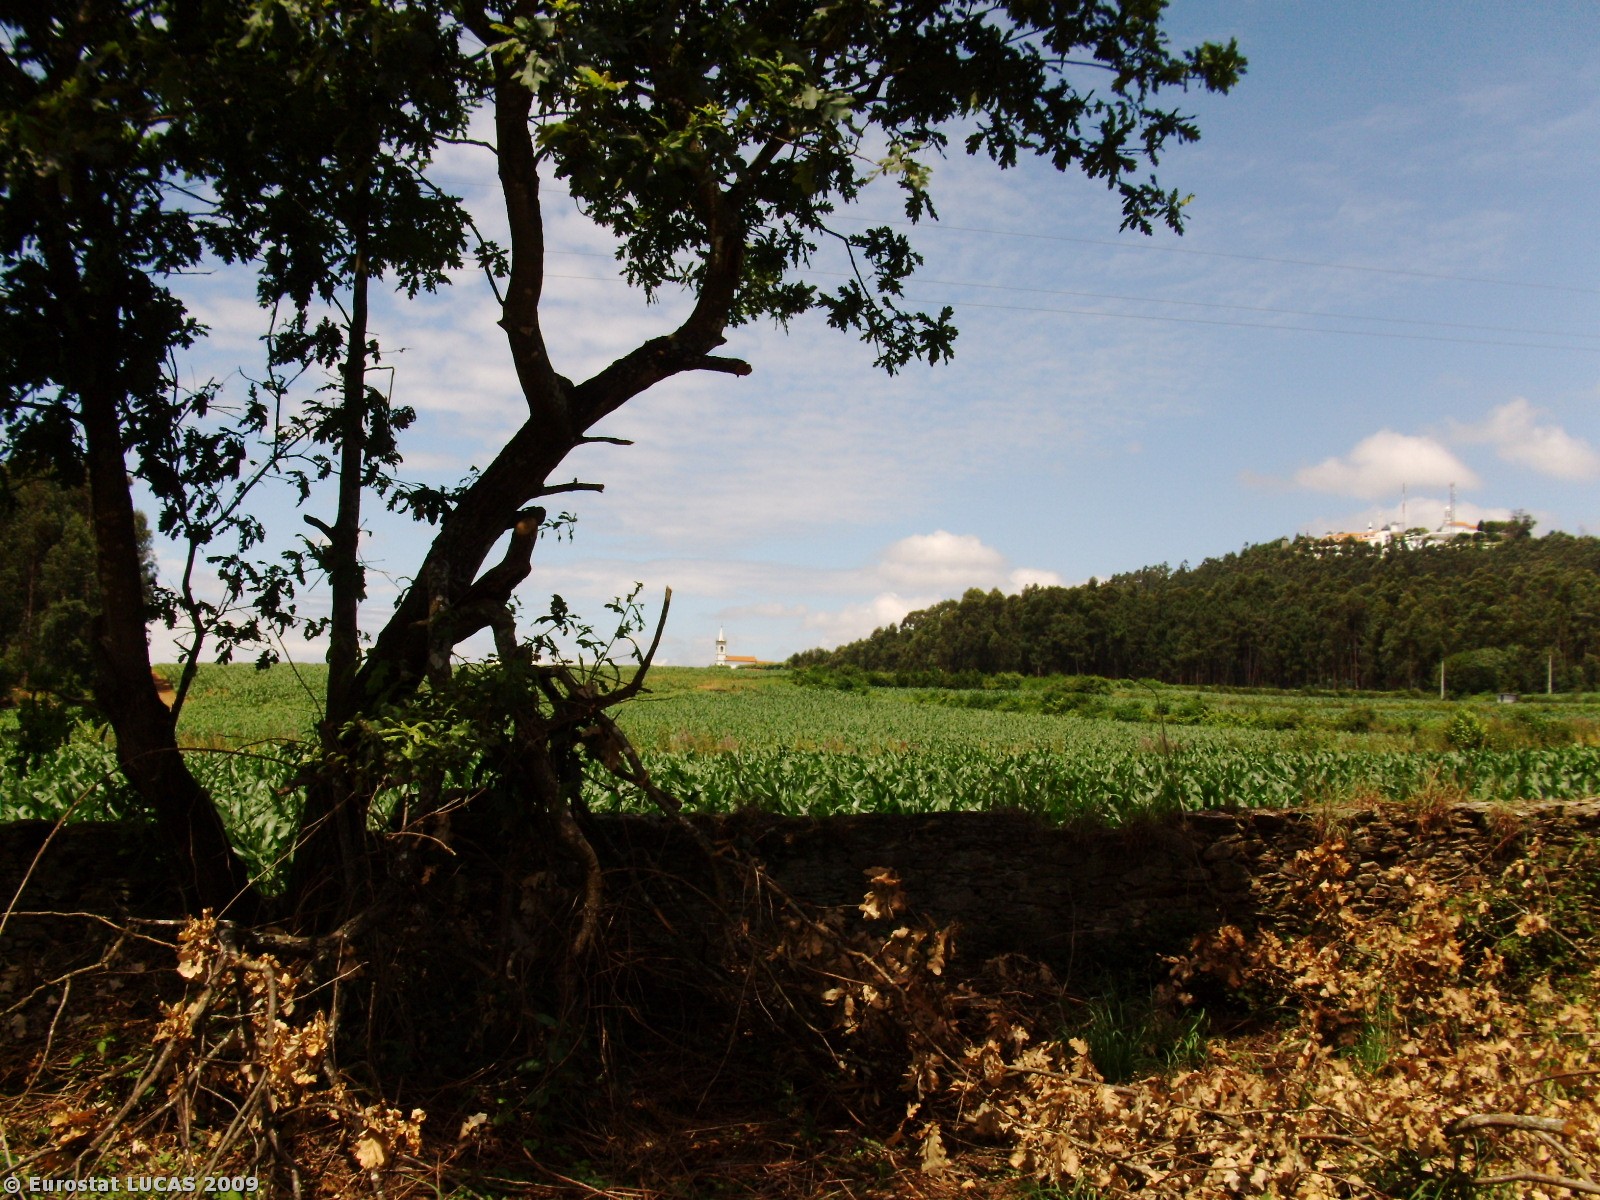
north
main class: Woodland
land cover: Broadleaved woodland
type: acidophilous oak and oak-birch forest
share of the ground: 10 - 25 %
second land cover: Spontaneously vegetated surfaces
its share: 25 - 50 %
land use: Forestry
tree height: > 5 m
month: June
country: PT
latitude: 41.4264
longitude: -8.7198
